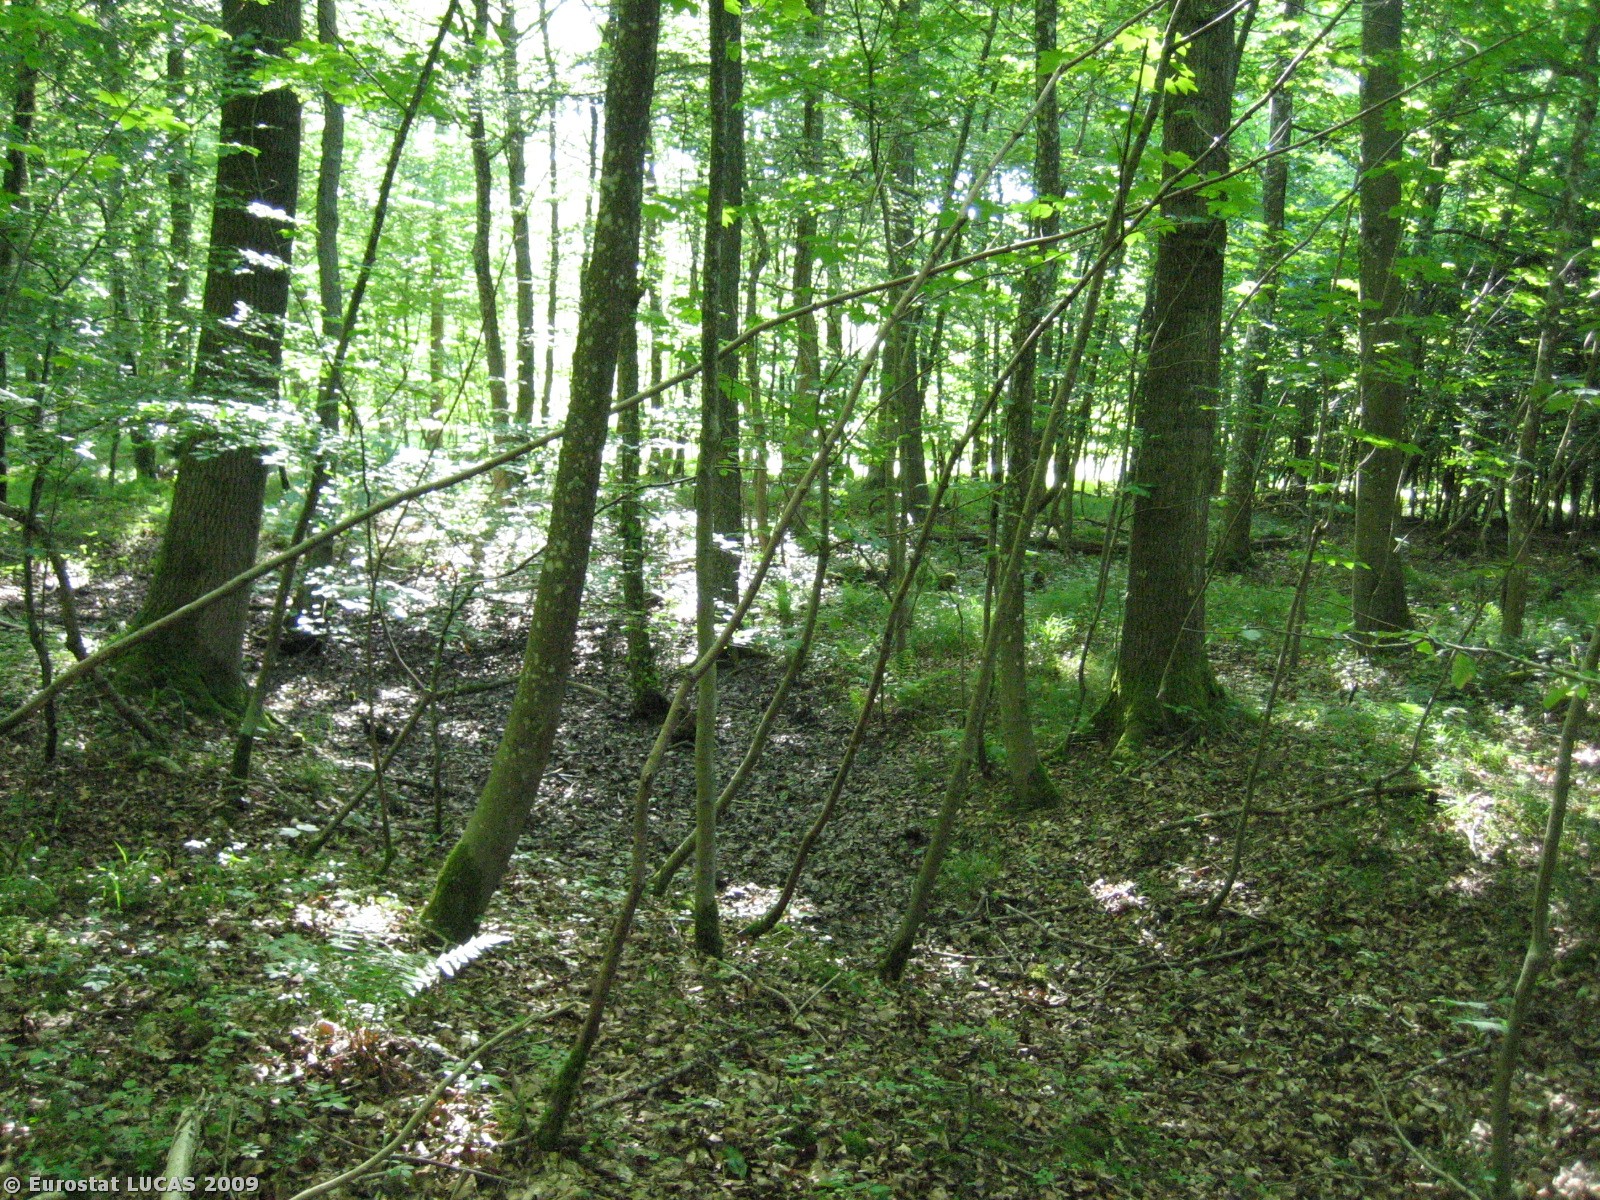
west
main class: Woodland
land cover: Broadleaved woodland
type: mesophytic deciduous forest
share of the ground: > 75 %
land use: Forestry
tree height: > 5 m
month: June
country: DK
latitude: 55.8101
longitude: 9.7928
